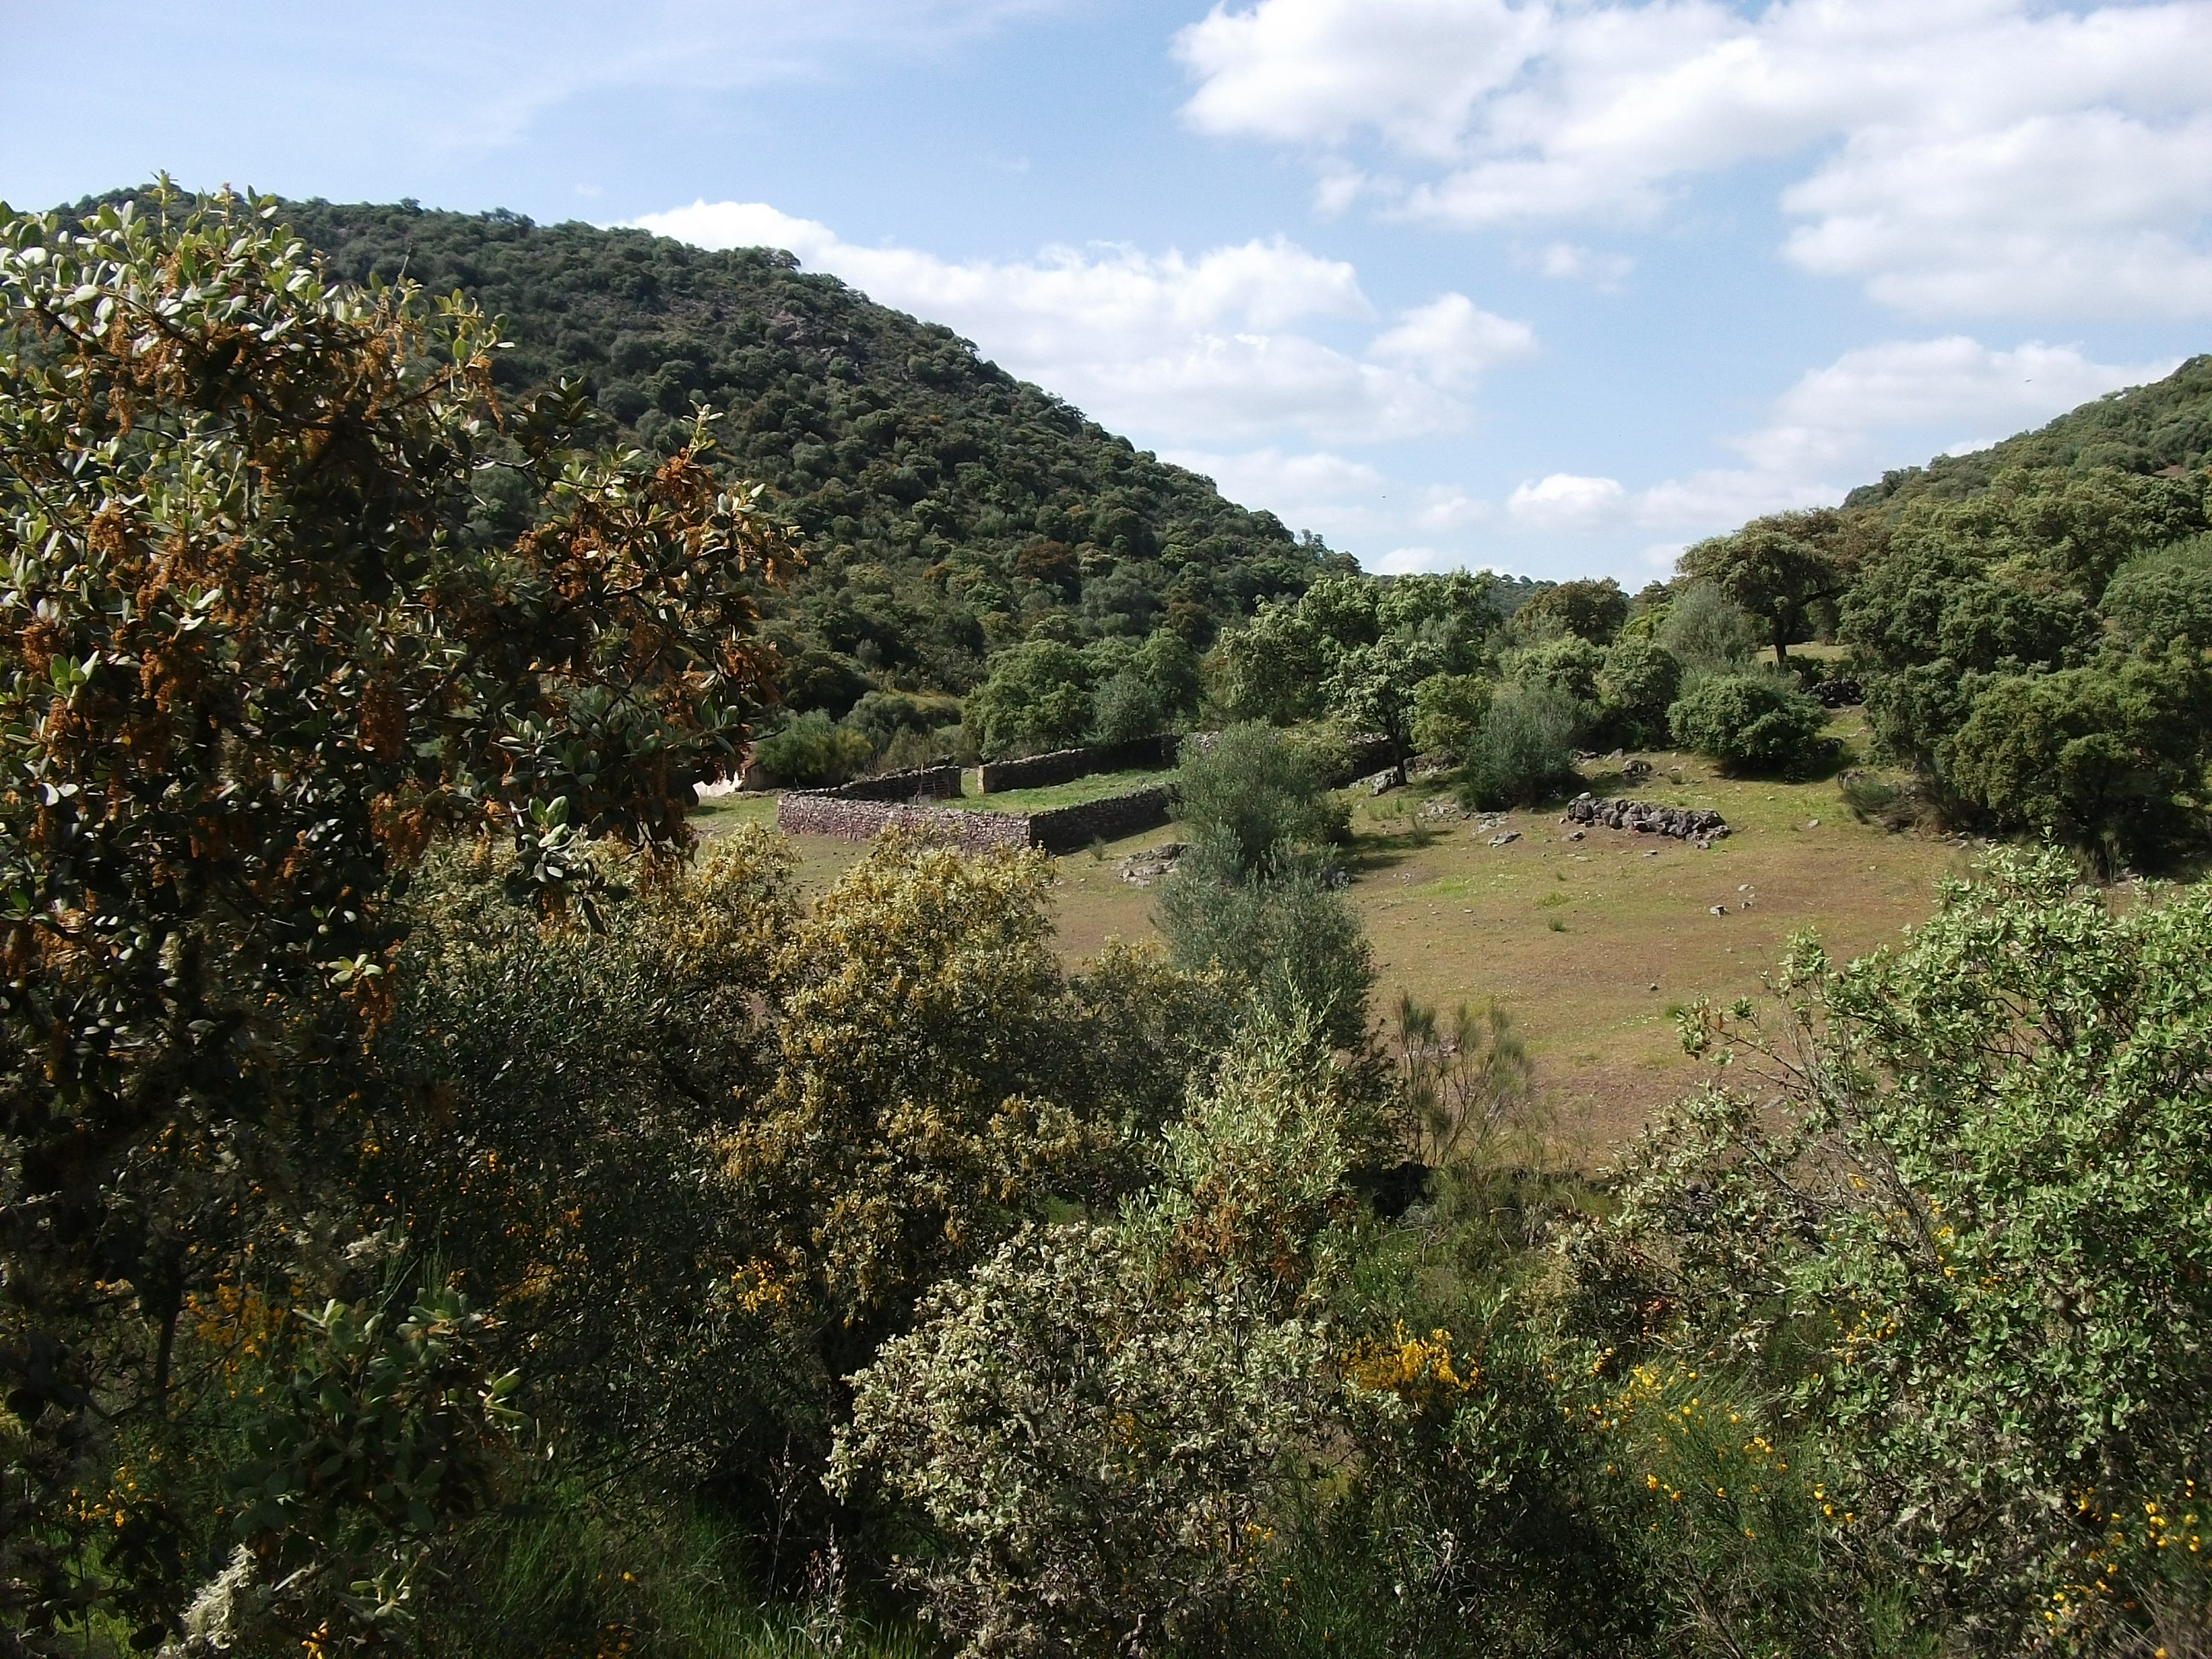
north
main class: Woodland
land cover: Broadleaved woodland
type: broadleaved evergreen forest
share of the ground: 25 - 50 %
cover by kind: shrubs 60 %, broadleaved forest trees 35 %, herbaceous plants 5 %
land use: Semi-natural and natural areas not in use
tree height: > 5 m
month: April
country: ES
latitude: 38.0738
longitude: -6.7738
